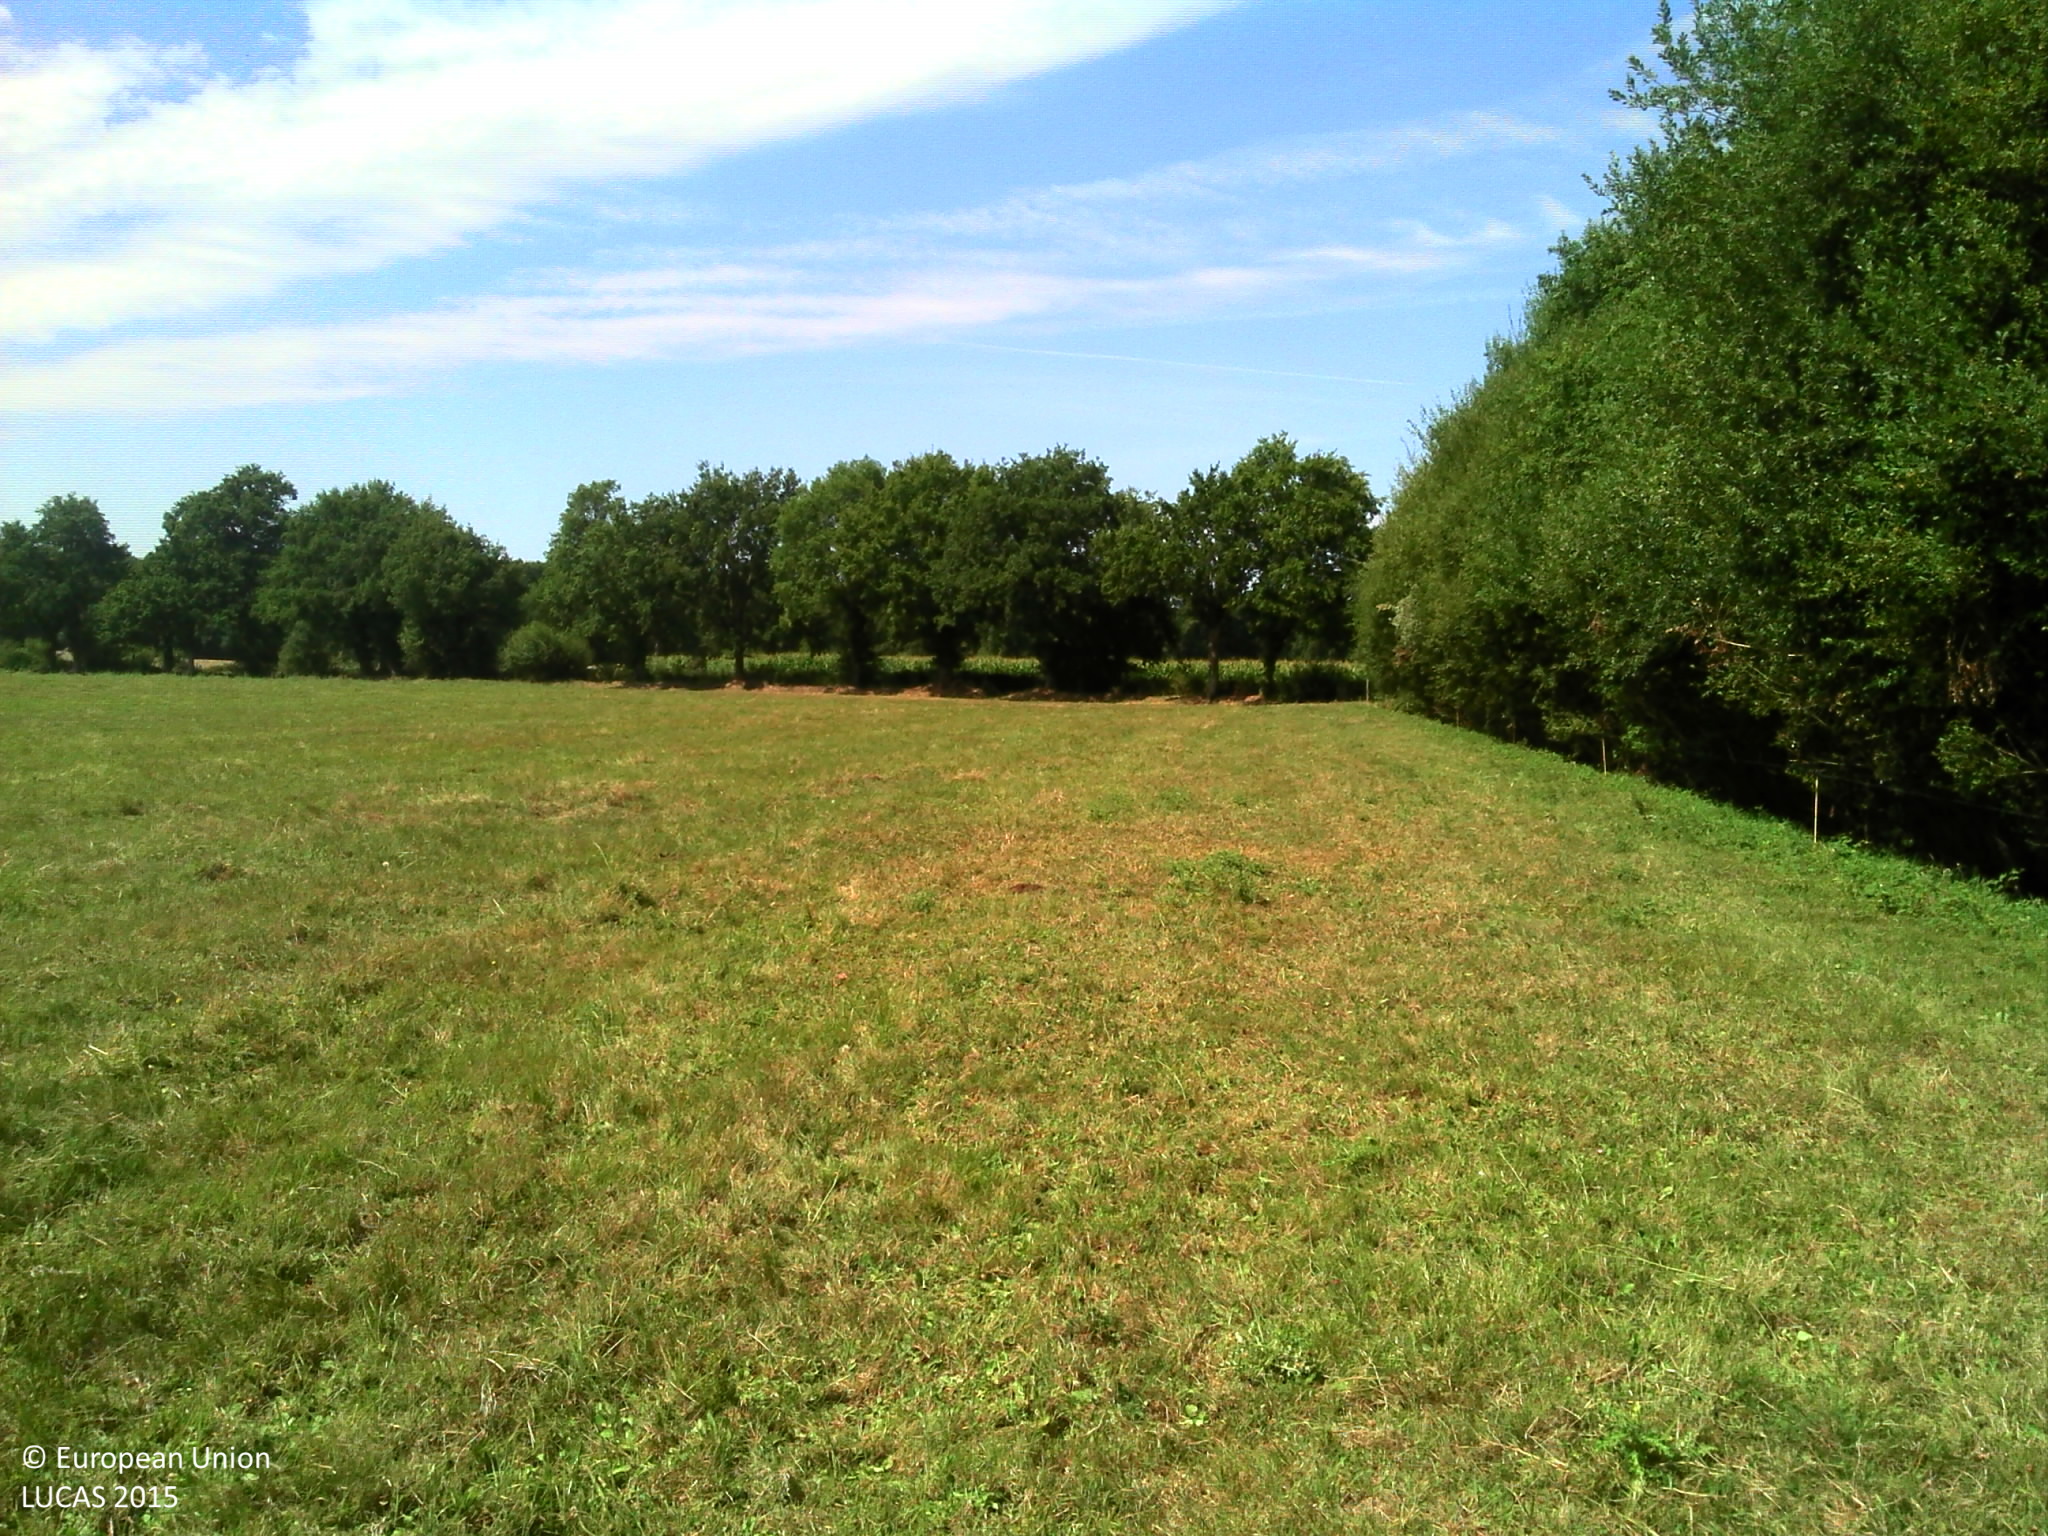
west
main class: Grassland
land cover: Grassland without tree/shrub cover
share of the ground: > 75 %
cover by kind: herbaceous plants 100 %
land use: Agriculture (excluding fallow land and kitchen gardens)
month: August
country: FR
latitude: 47.9272
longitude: -1.1625
